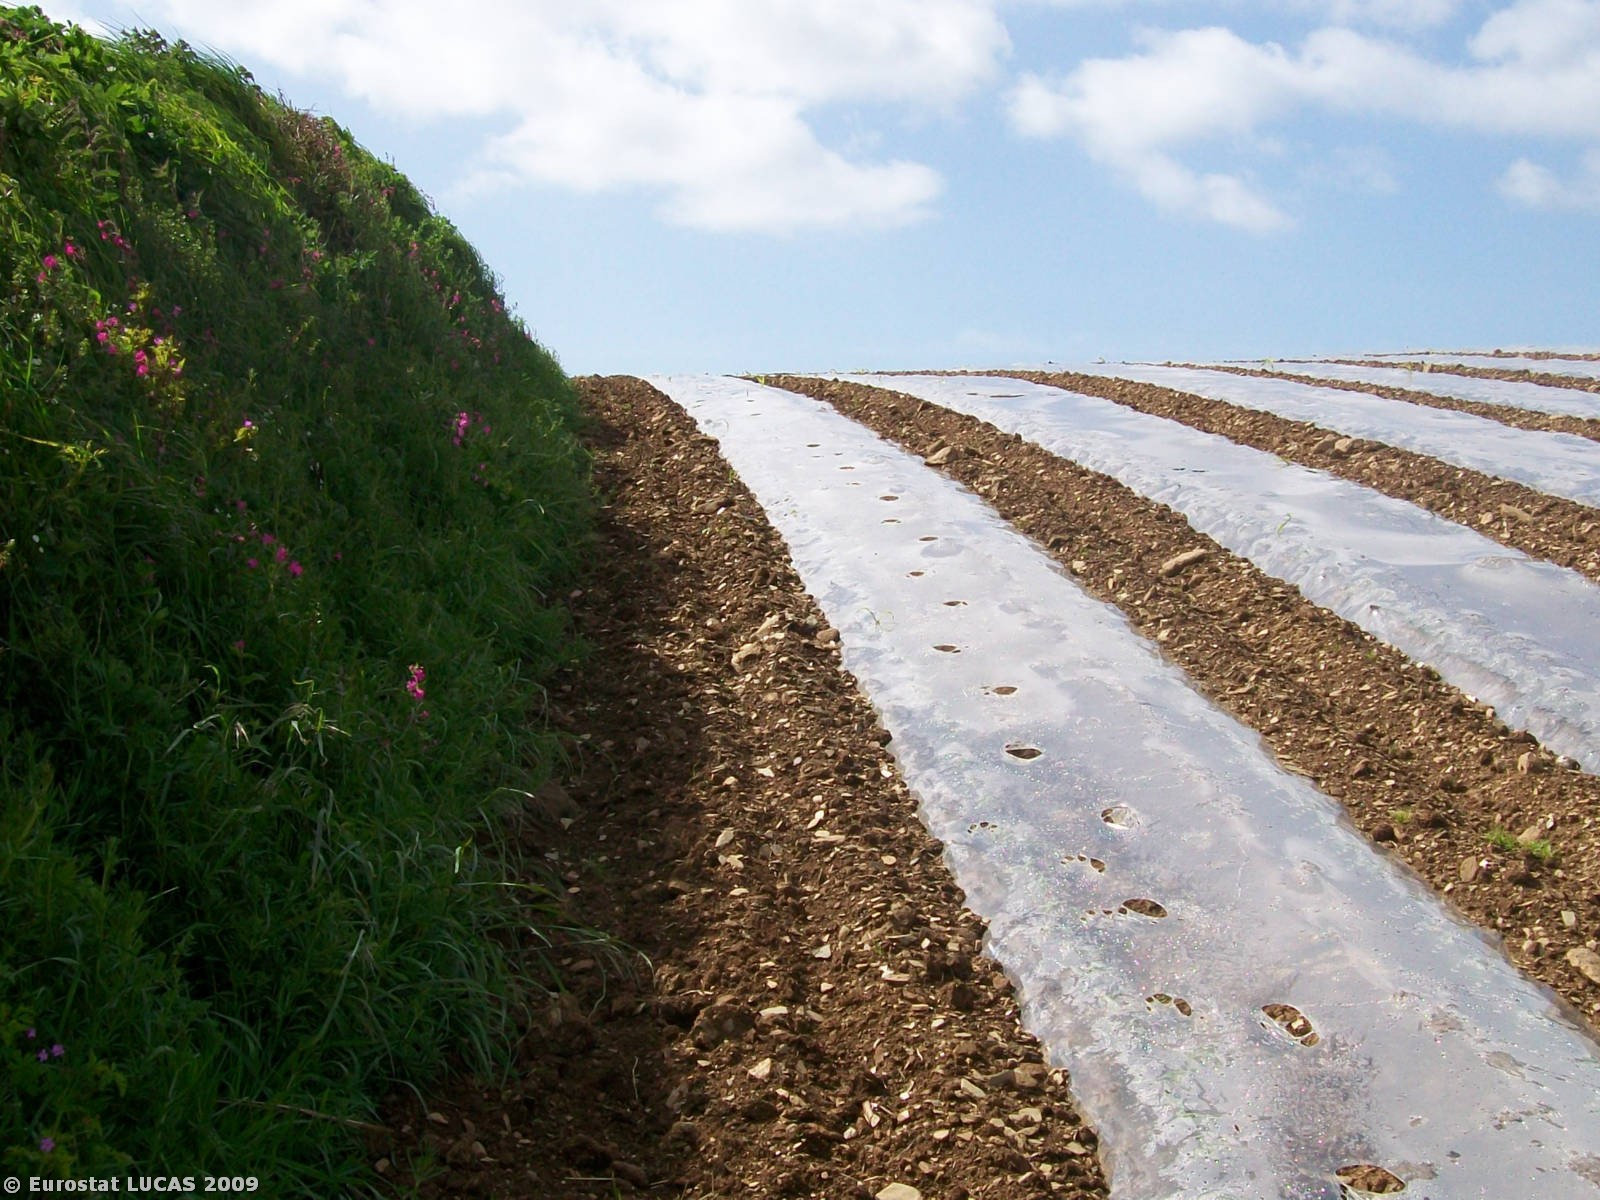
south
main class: Cropland
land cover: Maize
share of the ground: < 10 %
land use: Agriculture (excluding fallow land and kitchen gardens)
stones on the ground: 25 - 50 %
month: May
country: GB
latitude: 50.4131
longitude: -4.2702
